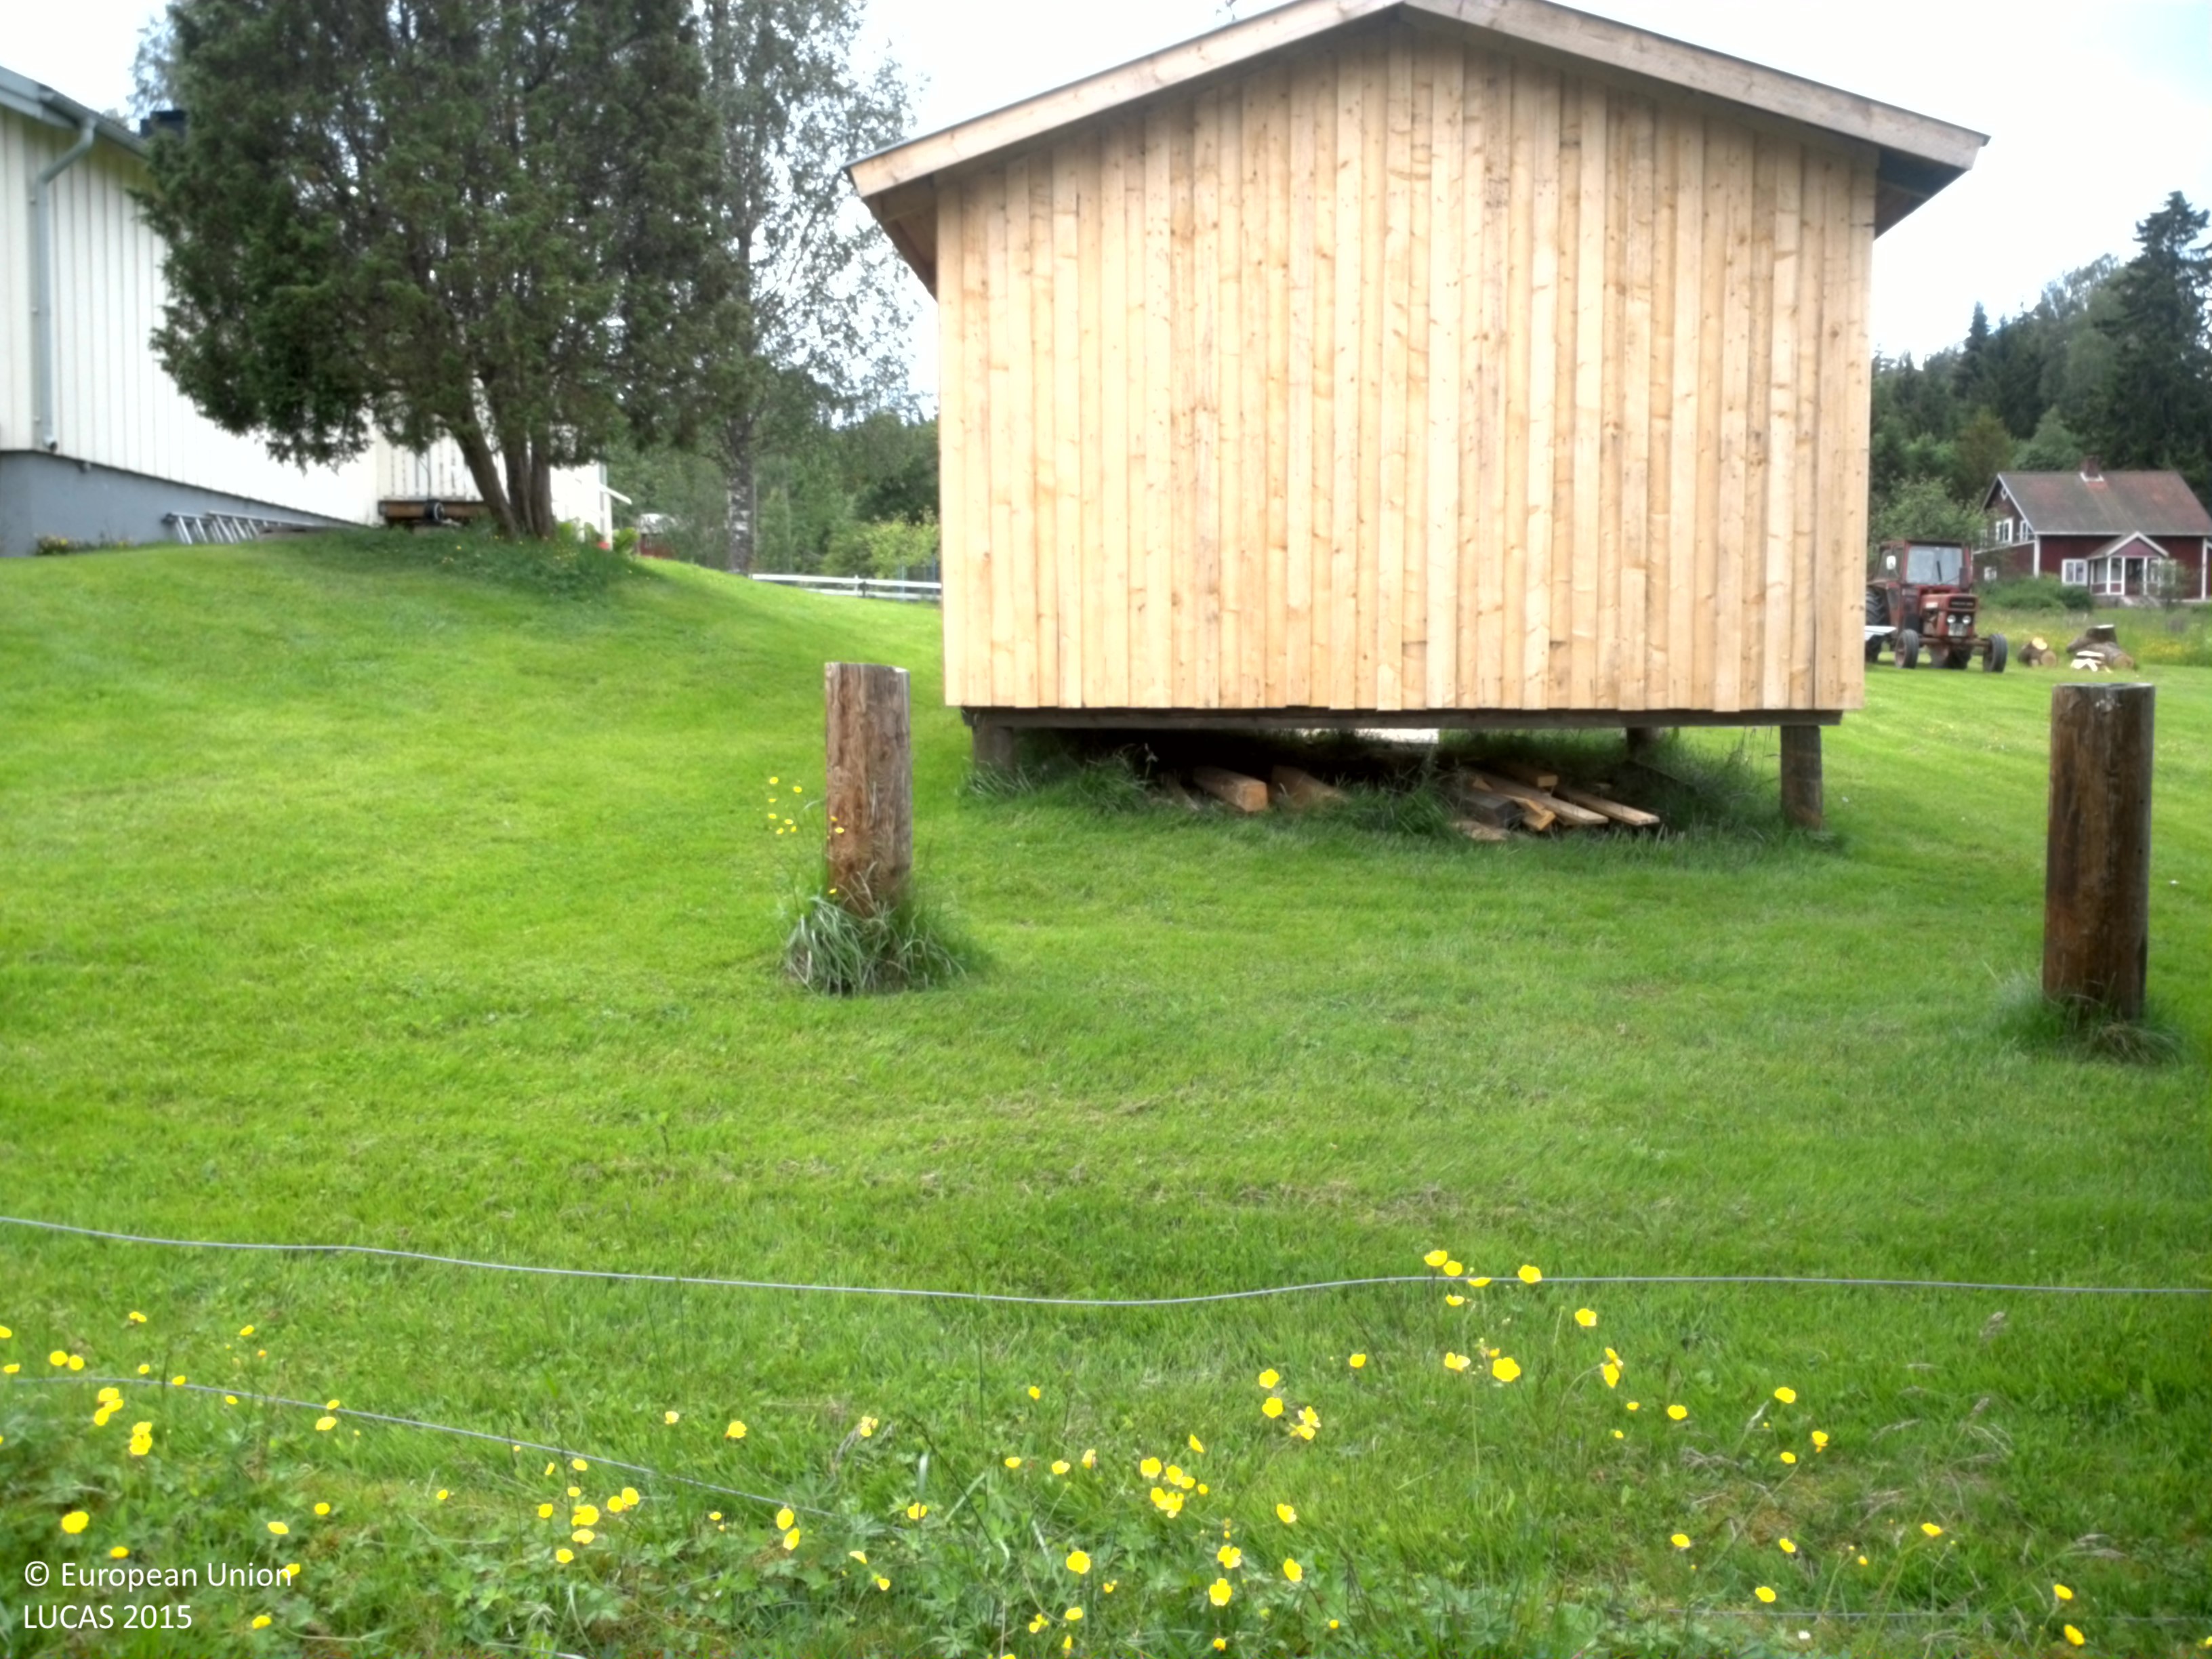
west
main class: Grassland
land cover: Grassland without tree/shrub cover
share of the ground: > 75 %
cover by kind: herbaceous plants 90 %, unconsolidated bare surface 10 %
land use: Agriculture (excluding fallow land and kitchen gardens)
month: June
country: SE
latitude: 59.7815
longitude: 12.4337
